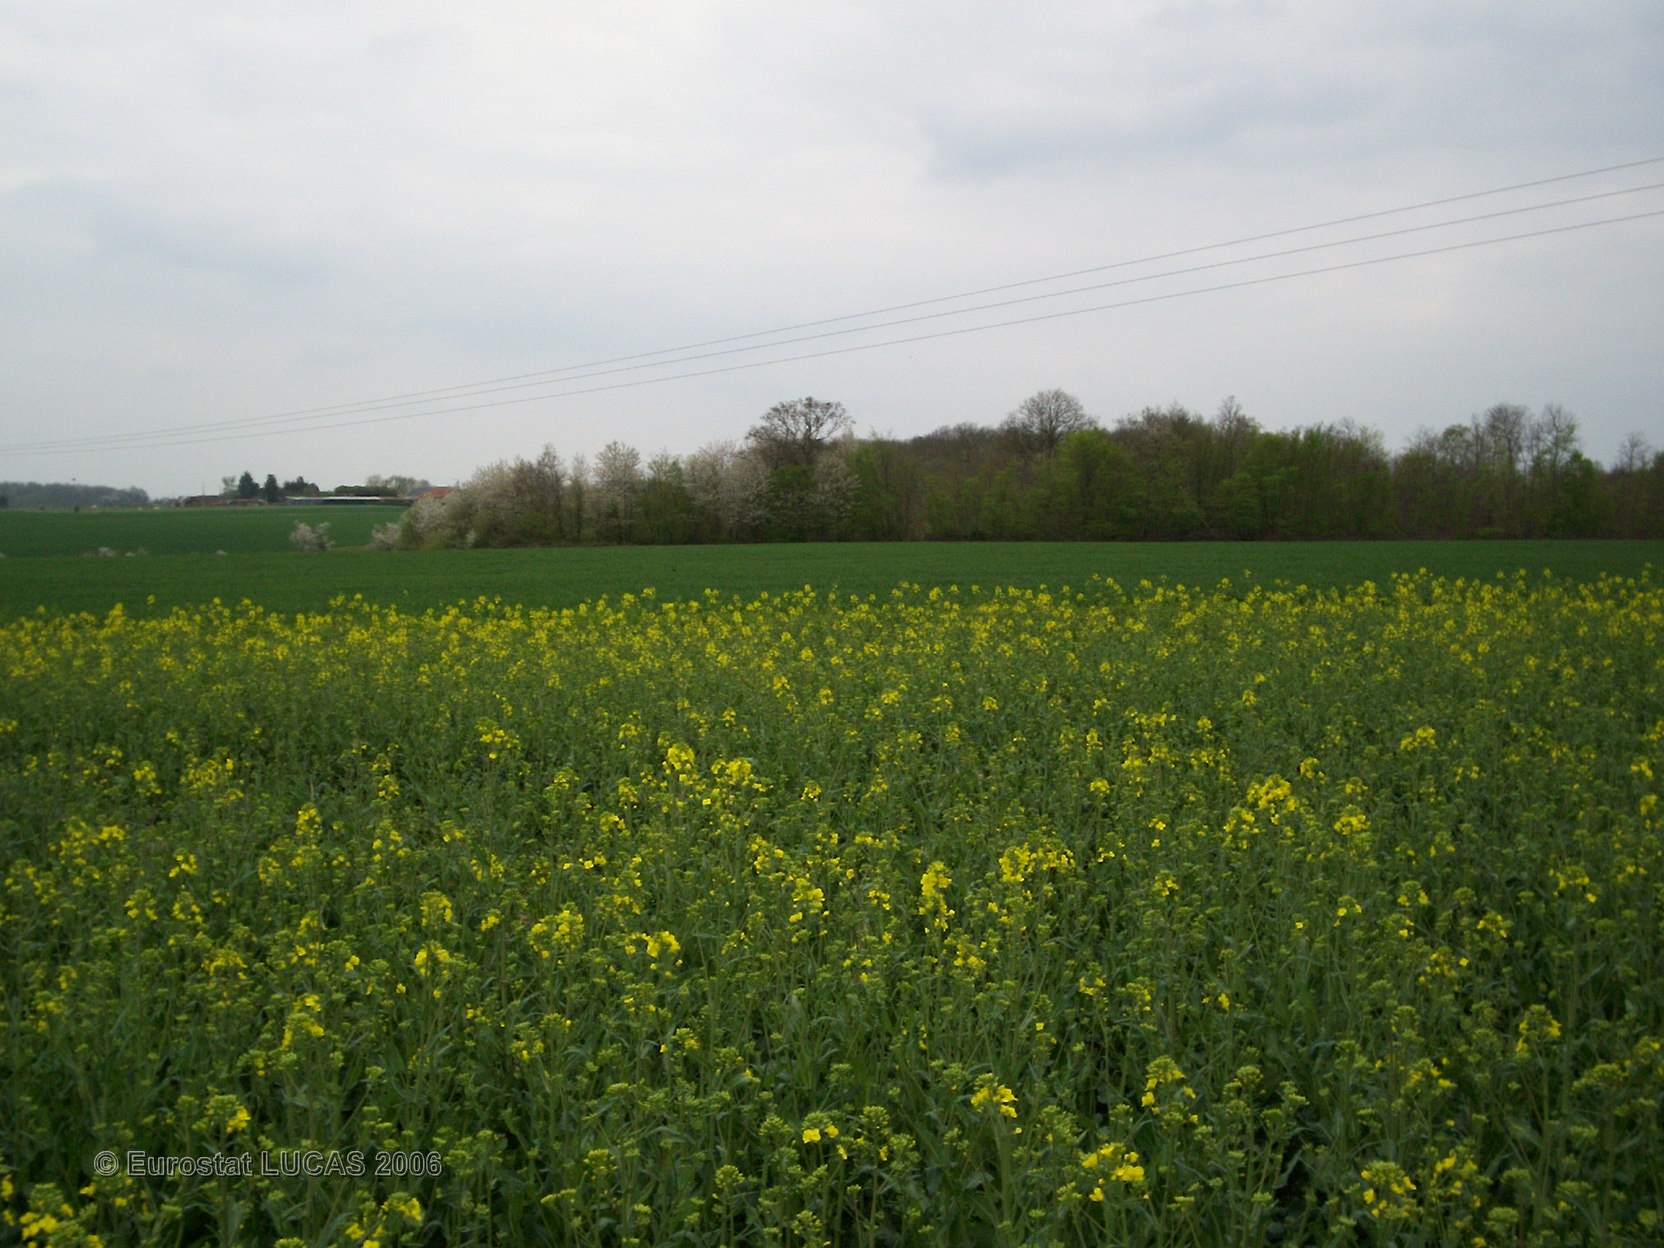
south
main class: Cropland
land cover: Rape and turnip rape
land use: Agriculture (excluding fallow land and kitchen gardens)
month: April
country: FR
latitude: 48.8725
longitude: 1.0487
